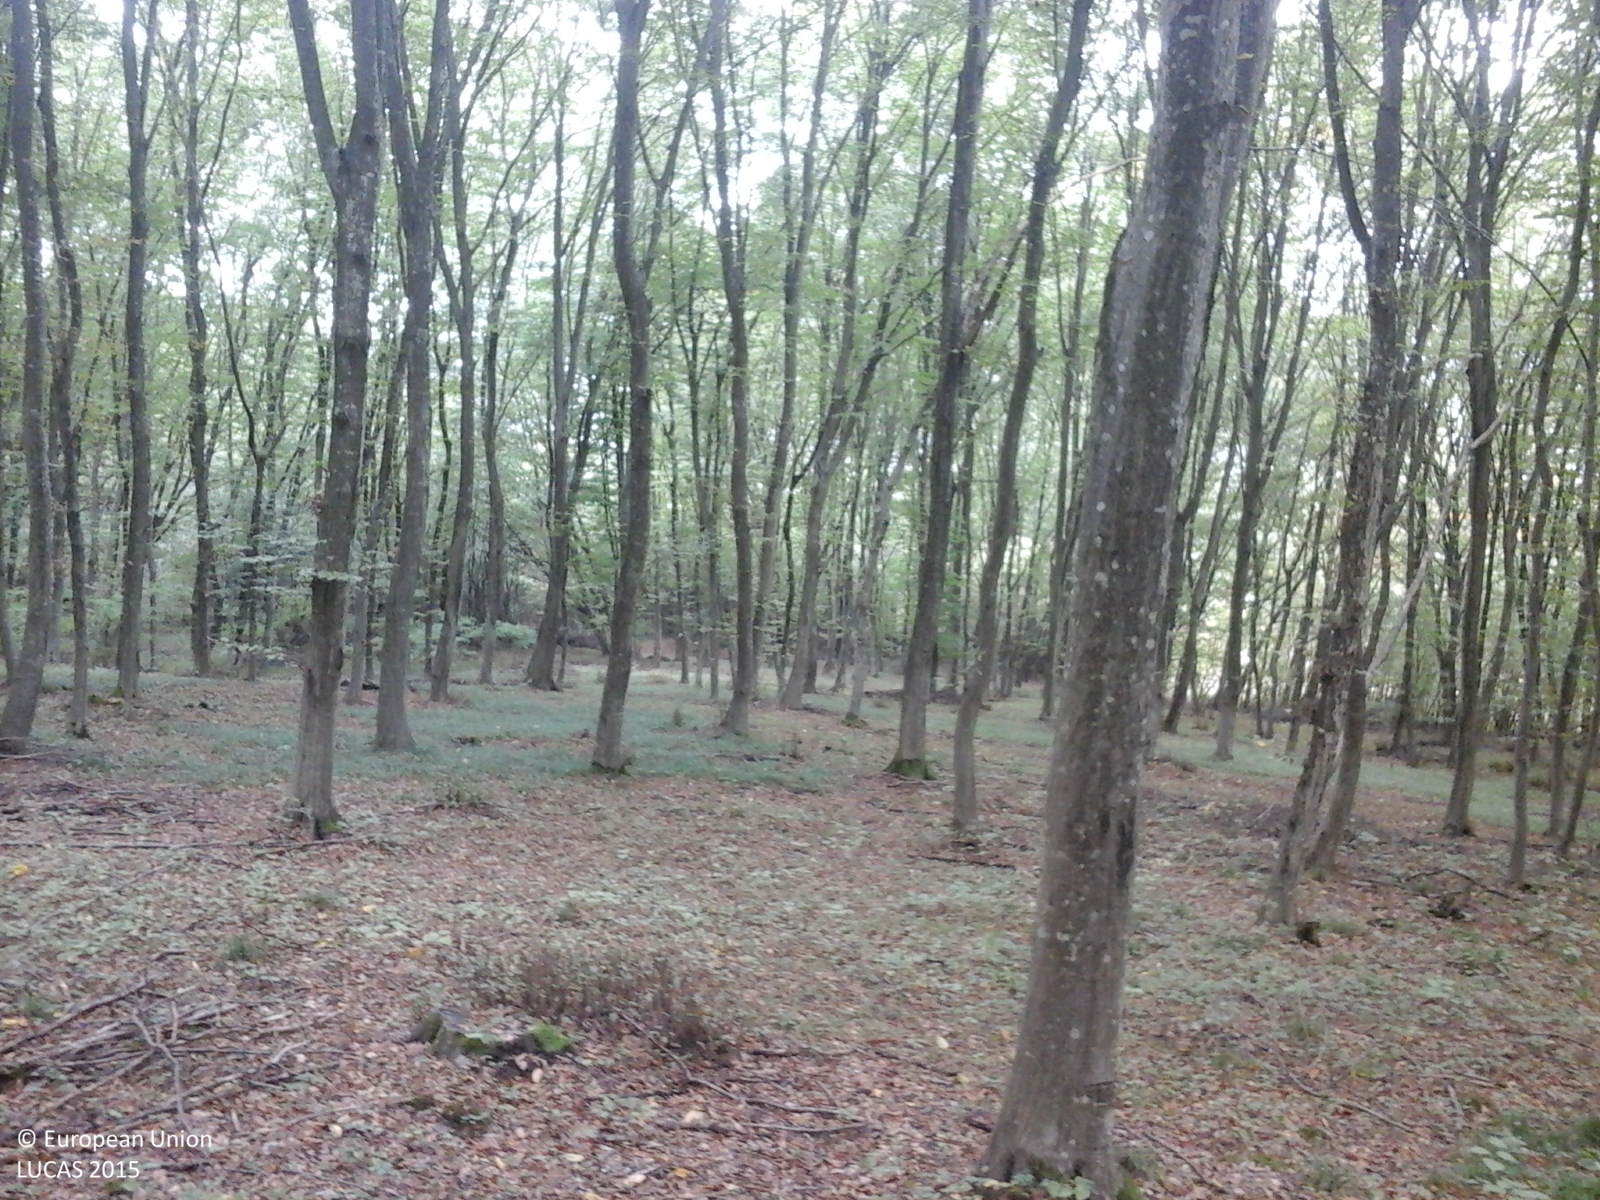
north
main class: Woodland
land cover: Broadleaved woodland
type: beech forest
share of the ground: > 75 %
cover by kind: broadleaved forest trees 100 %
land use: Forestry
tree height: > 5 m
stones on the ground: < 10 %
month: October
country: RO
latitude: 46.6548
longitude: 24.7681
